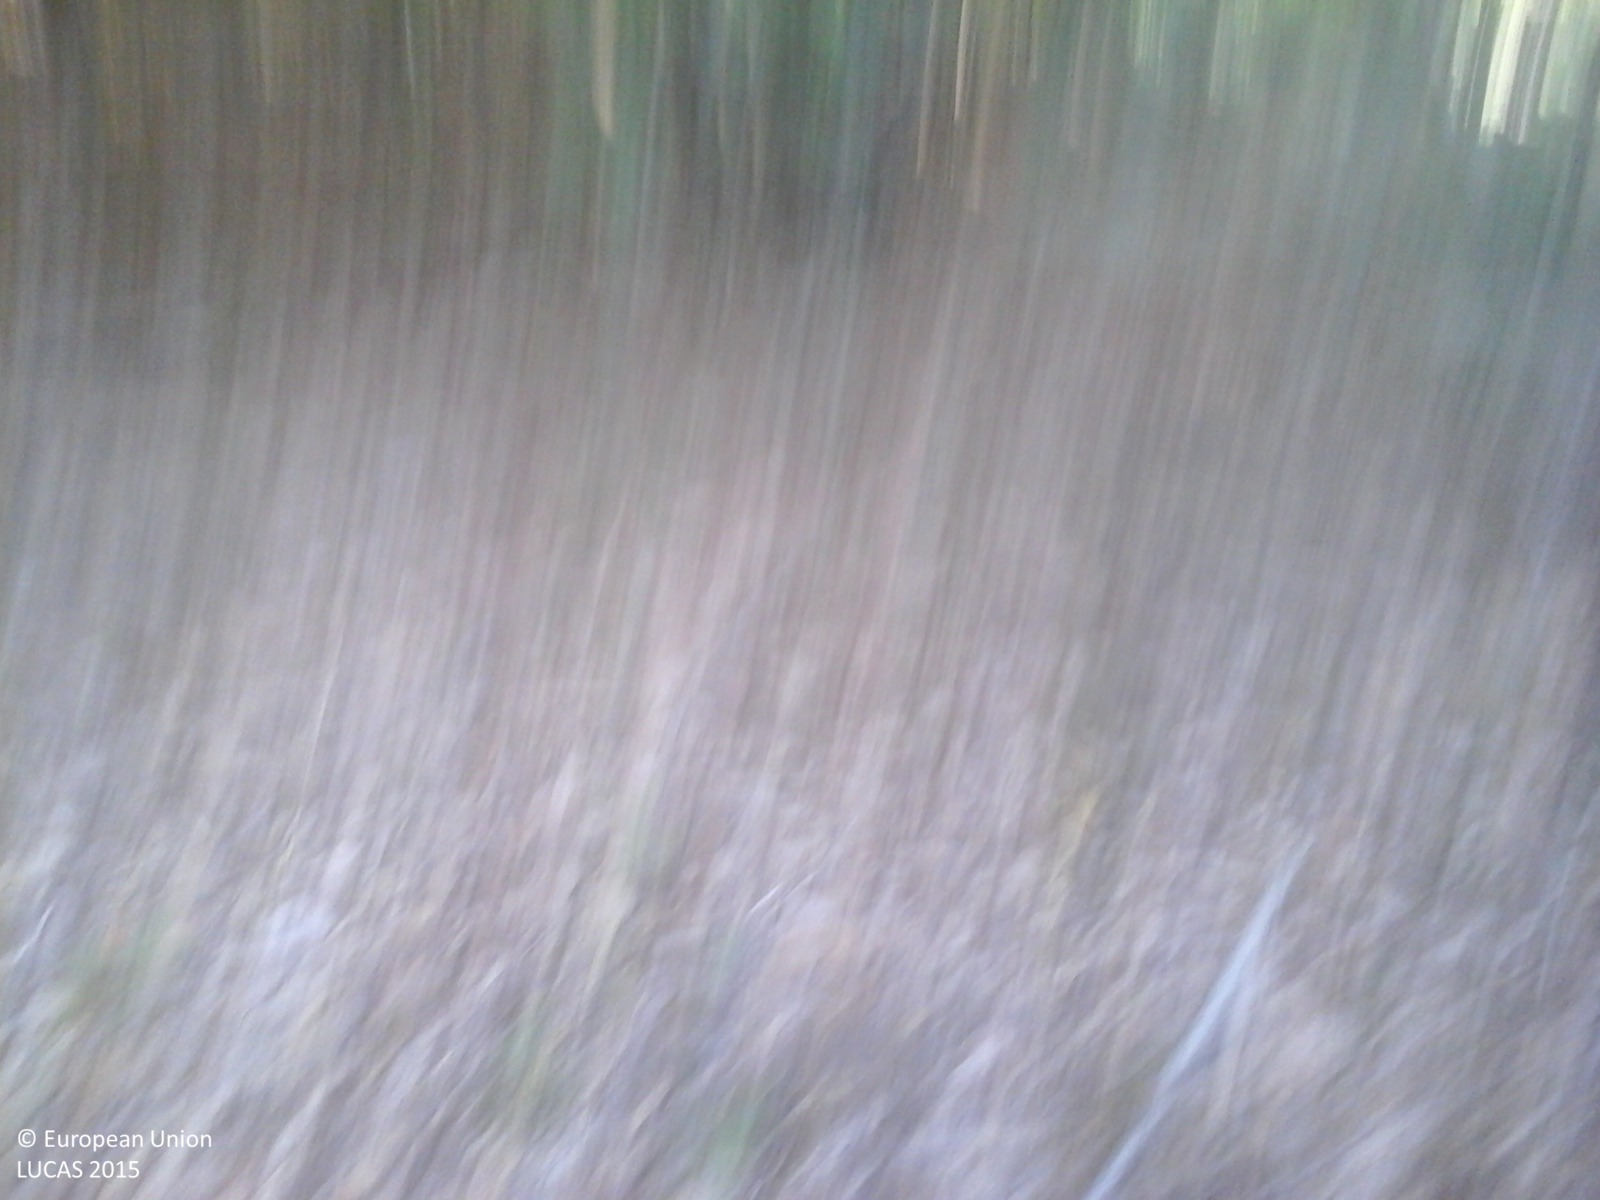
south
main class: Woodland
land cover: Broadleaved woodland
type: thermophilous deciduous forest
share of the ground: > 75 %
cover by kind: broadleaved forest trees 85 %, shrubs 10 %, herbaceous plants 5 %
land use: Forestry
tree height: > 5 m
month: July
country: IT
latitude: 42.8946
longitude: 11.5747
